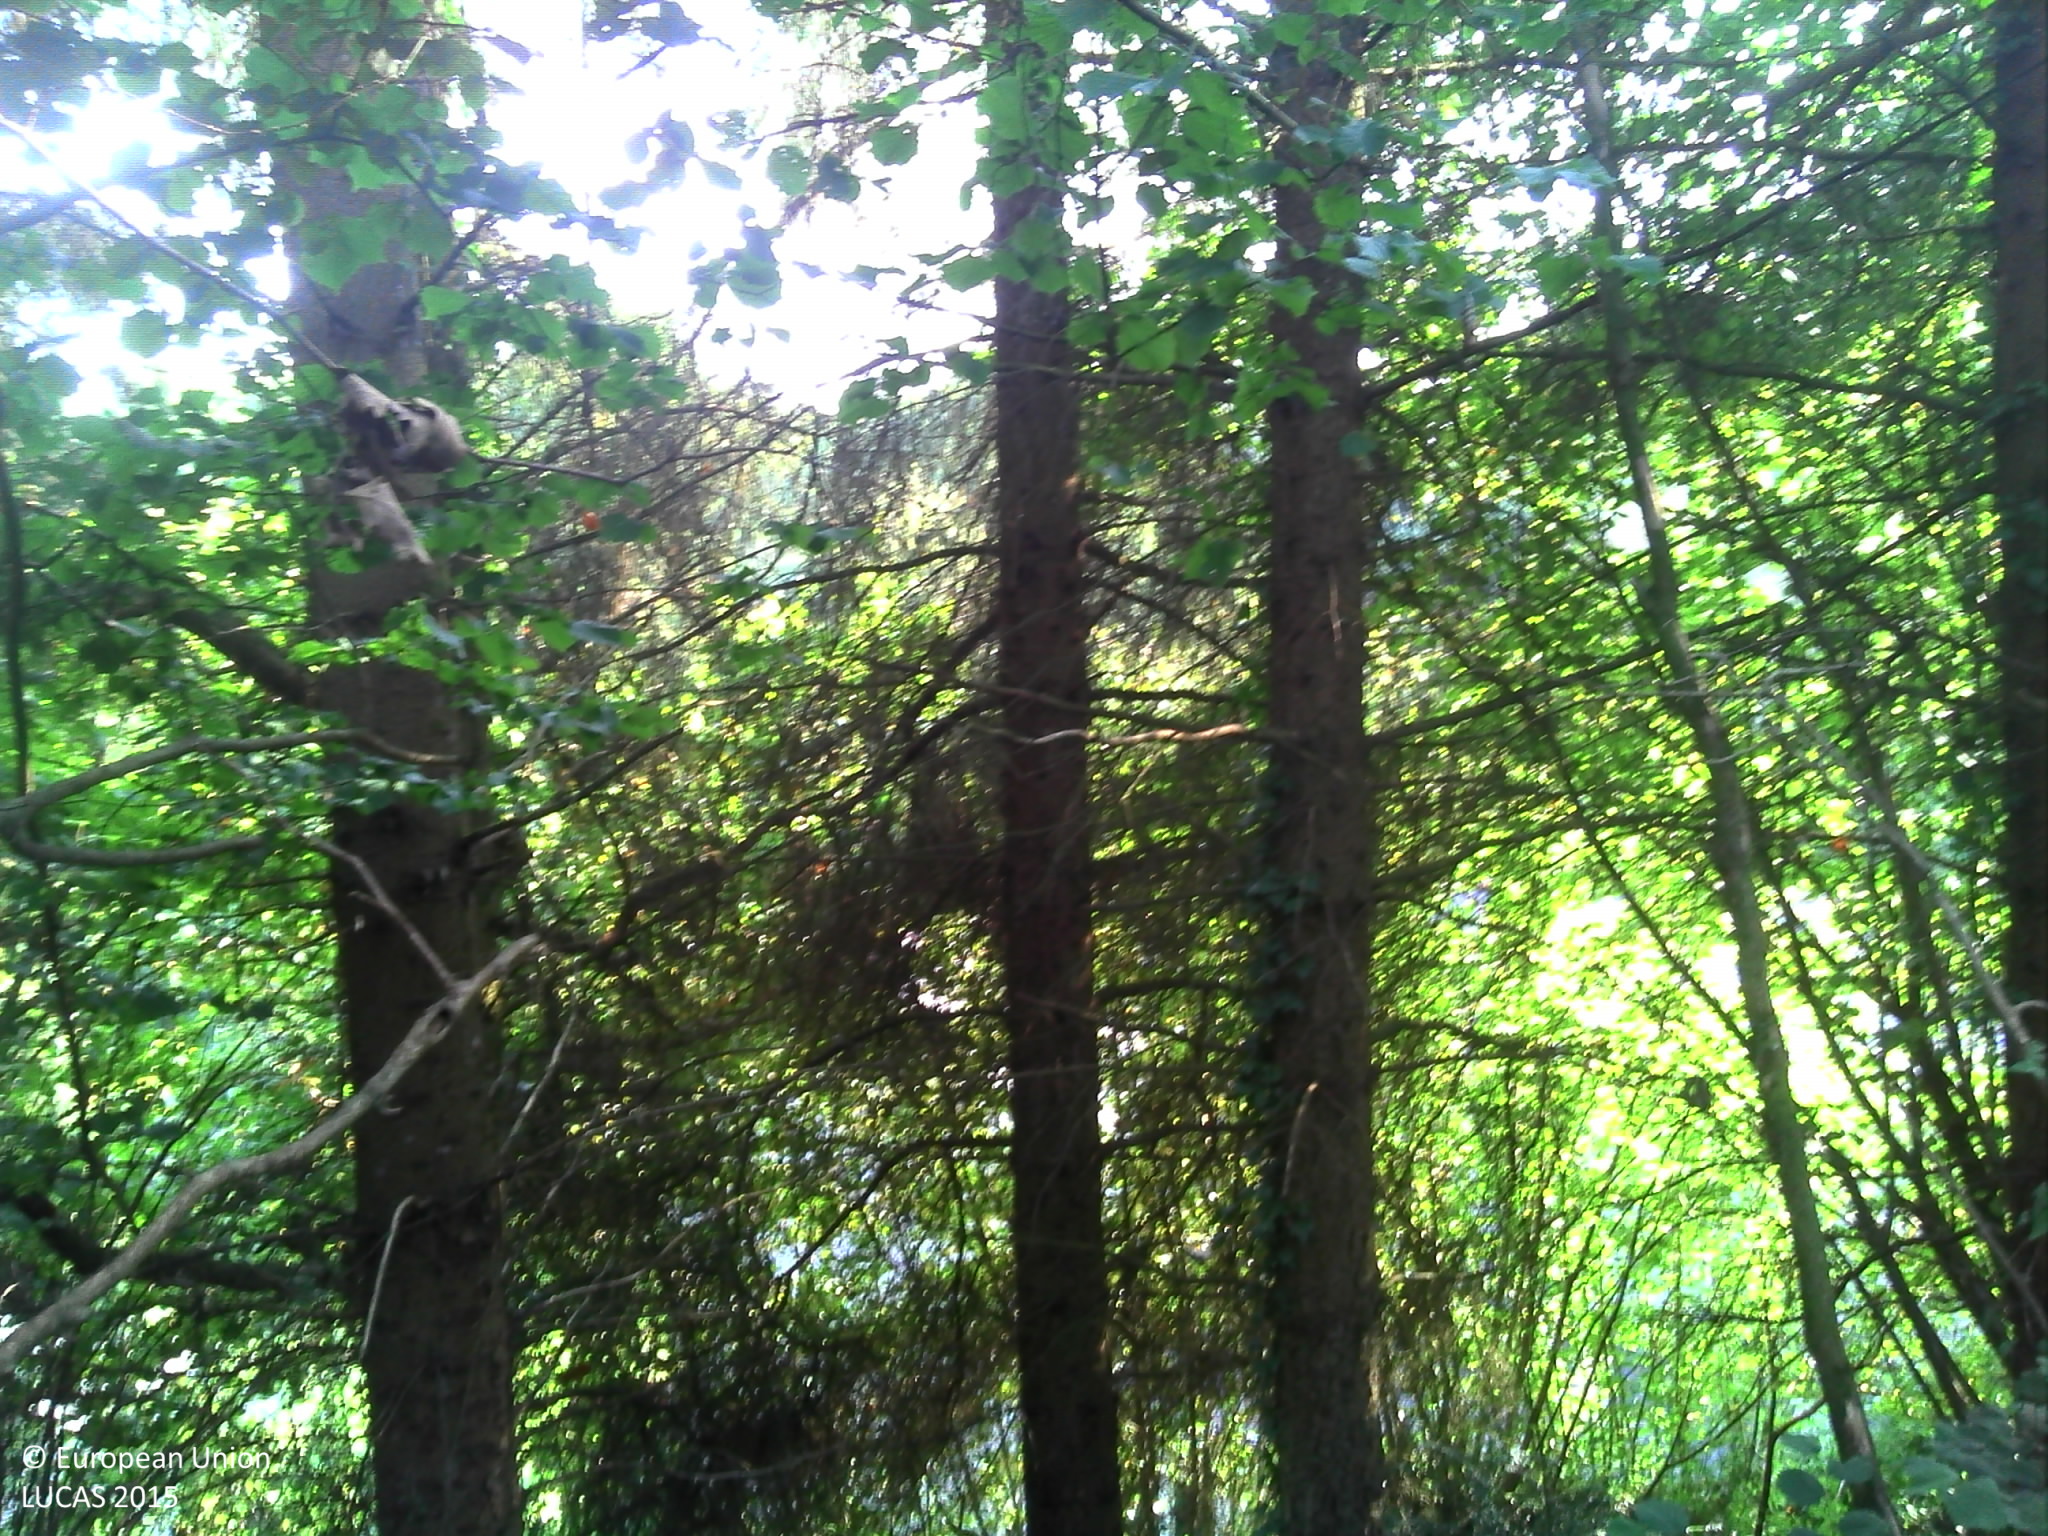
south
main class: Woodland
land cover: Spruce dominated mixed woodland
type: mesophytic deciduous forest
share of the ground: > 75 %
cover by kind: coniferous forest trees 60 %, broadleaved forest trees 25 %, herbaceous plants 15 %
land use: Forestry
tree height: > 5 m
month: October
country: FR
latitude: 48.5379
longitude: -3.1975
